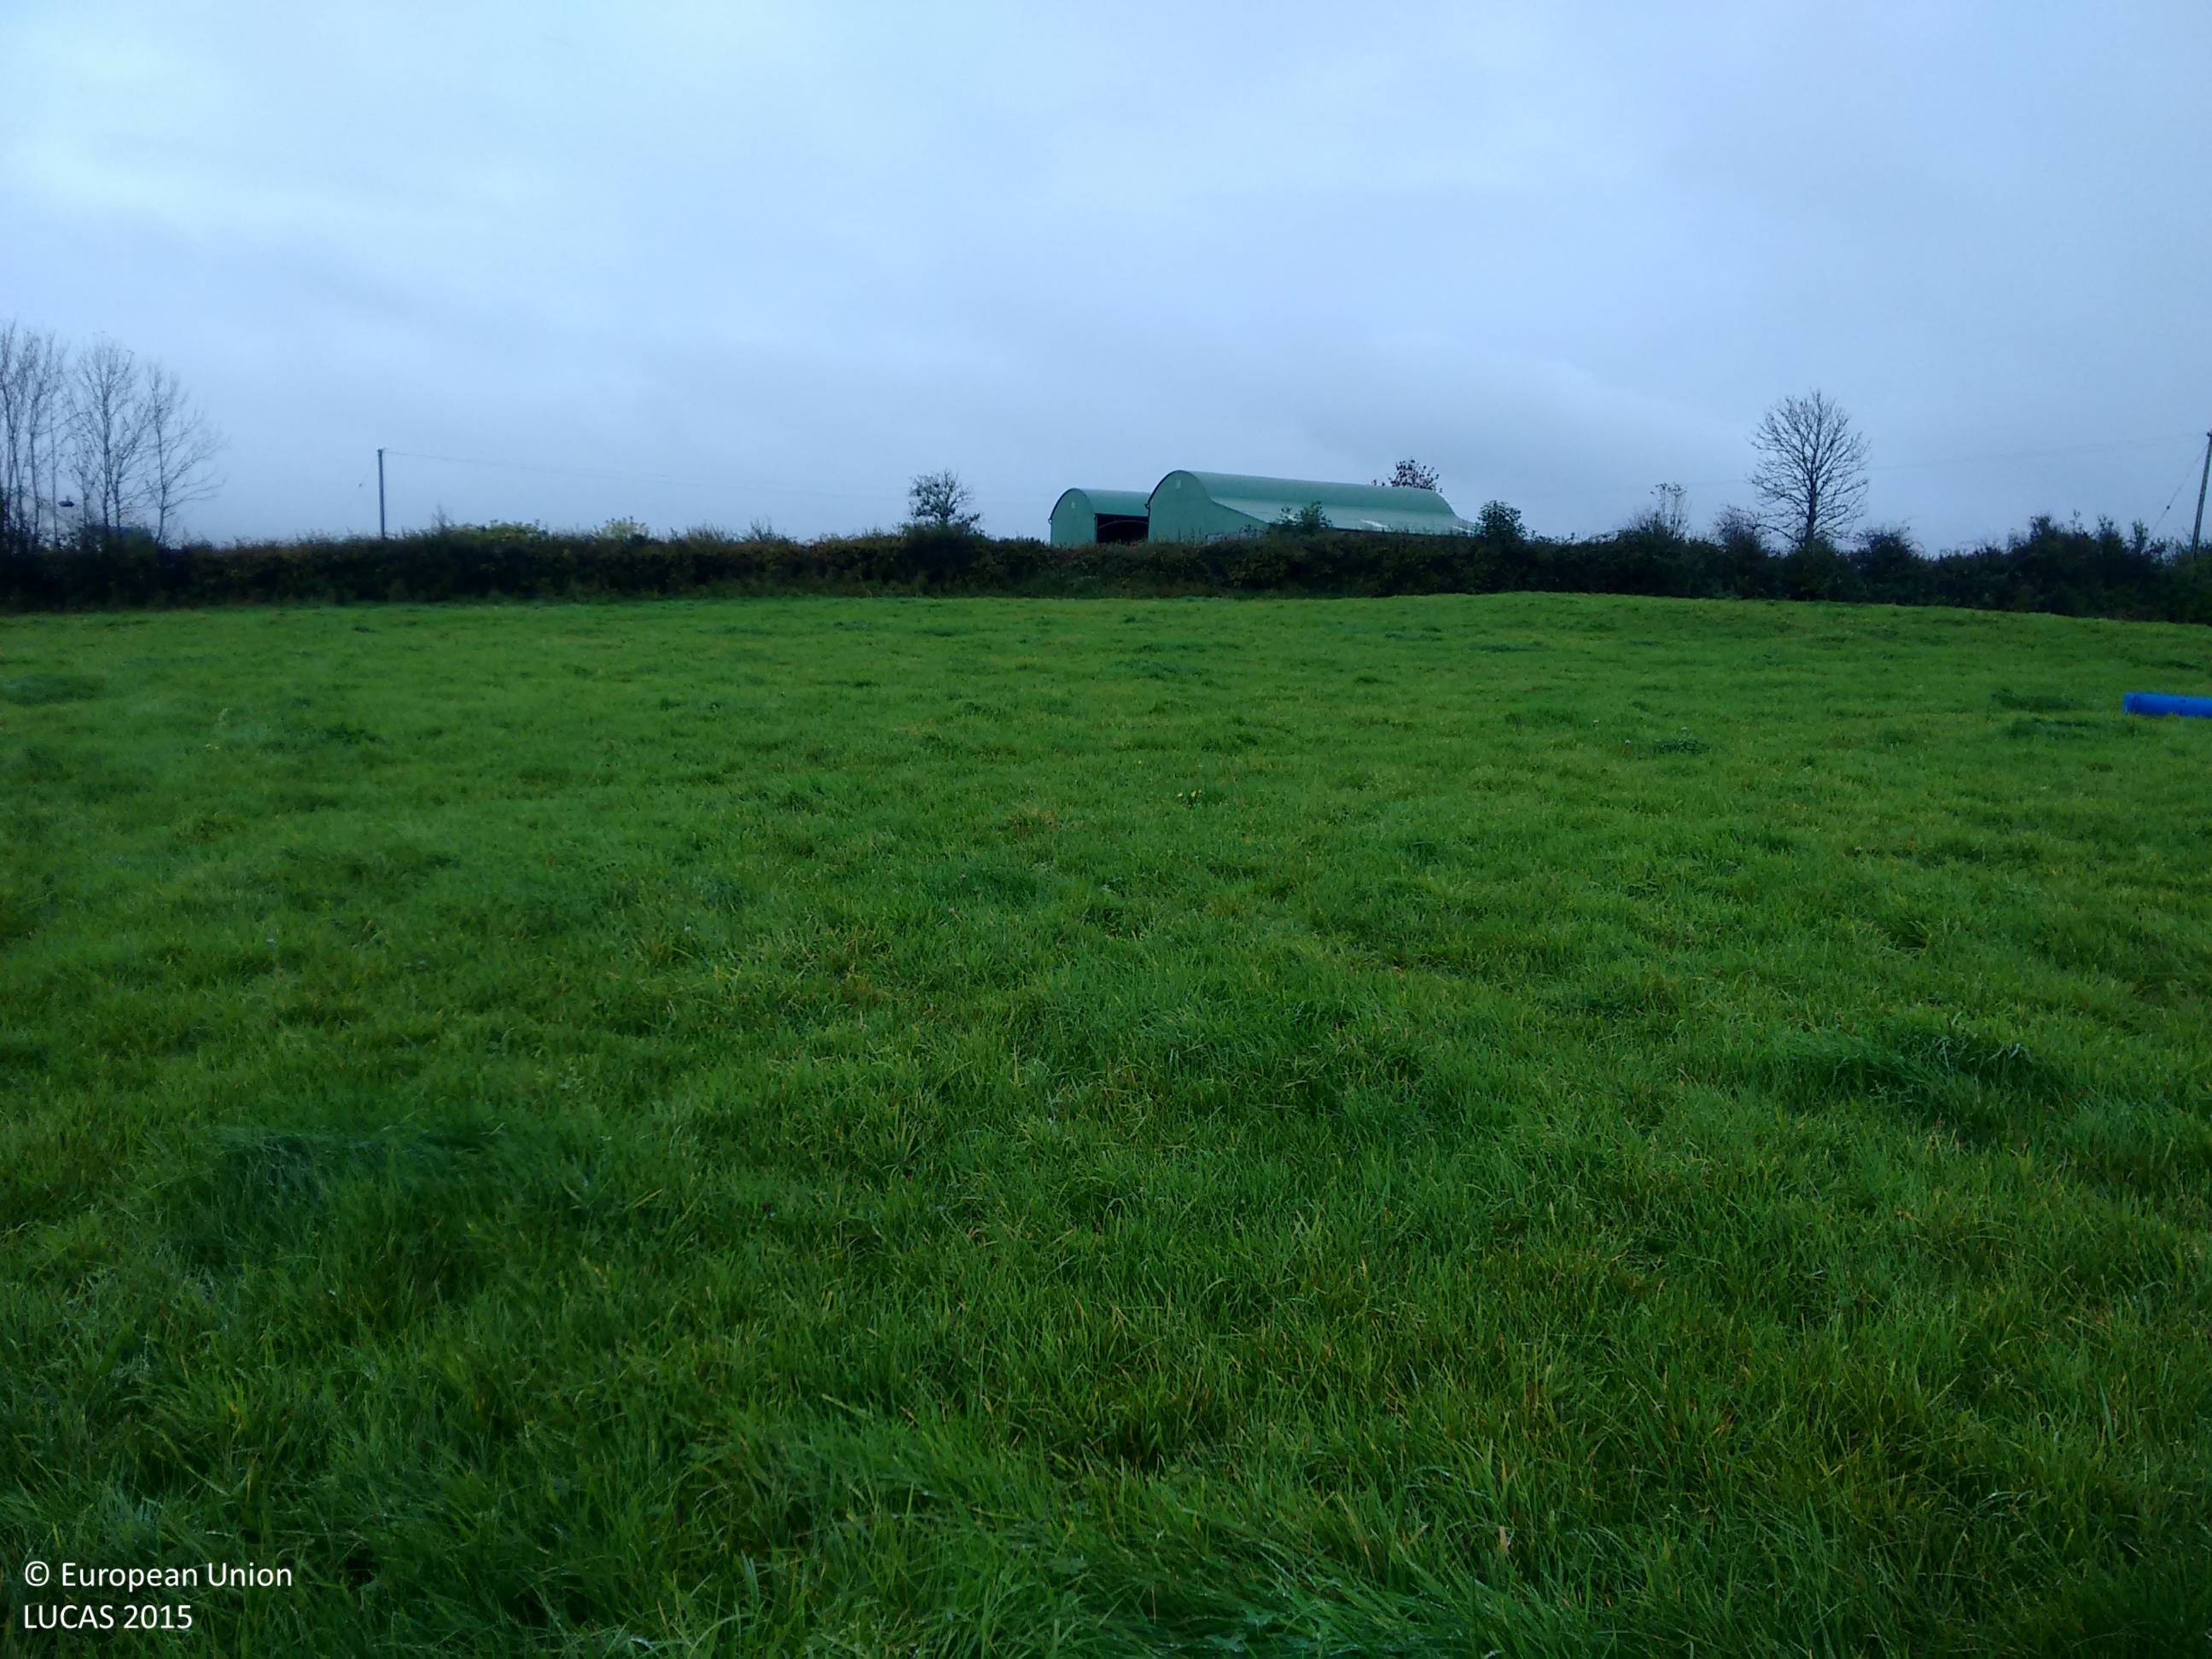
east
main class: Grassland
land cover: Grassland without tree/shrub cover
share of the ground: > 75 %
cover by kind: herbaceous plants 100 %
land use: Agriculture (excluding fallow land and kitchen gardens)
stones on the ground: < 10 %
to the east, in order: Grassland without tree/shrub cover; Abandoned hedges; Grass margins; Tracks; Grass margins; Fences; Grassland without tree/shrub cover; Artificial constructions in urban areas; Grassland without tree/shrub cover; Electric lines; Grassland without tree/shrub cover; Fences; Grassland without tree/shrub cover; Fences; Abandoned hedges; Grass margins; Tracks; Grass margins; Fences; Grassland without tree/shrub cover
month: October
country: IE
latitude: 53.8615
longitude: -8.1367
